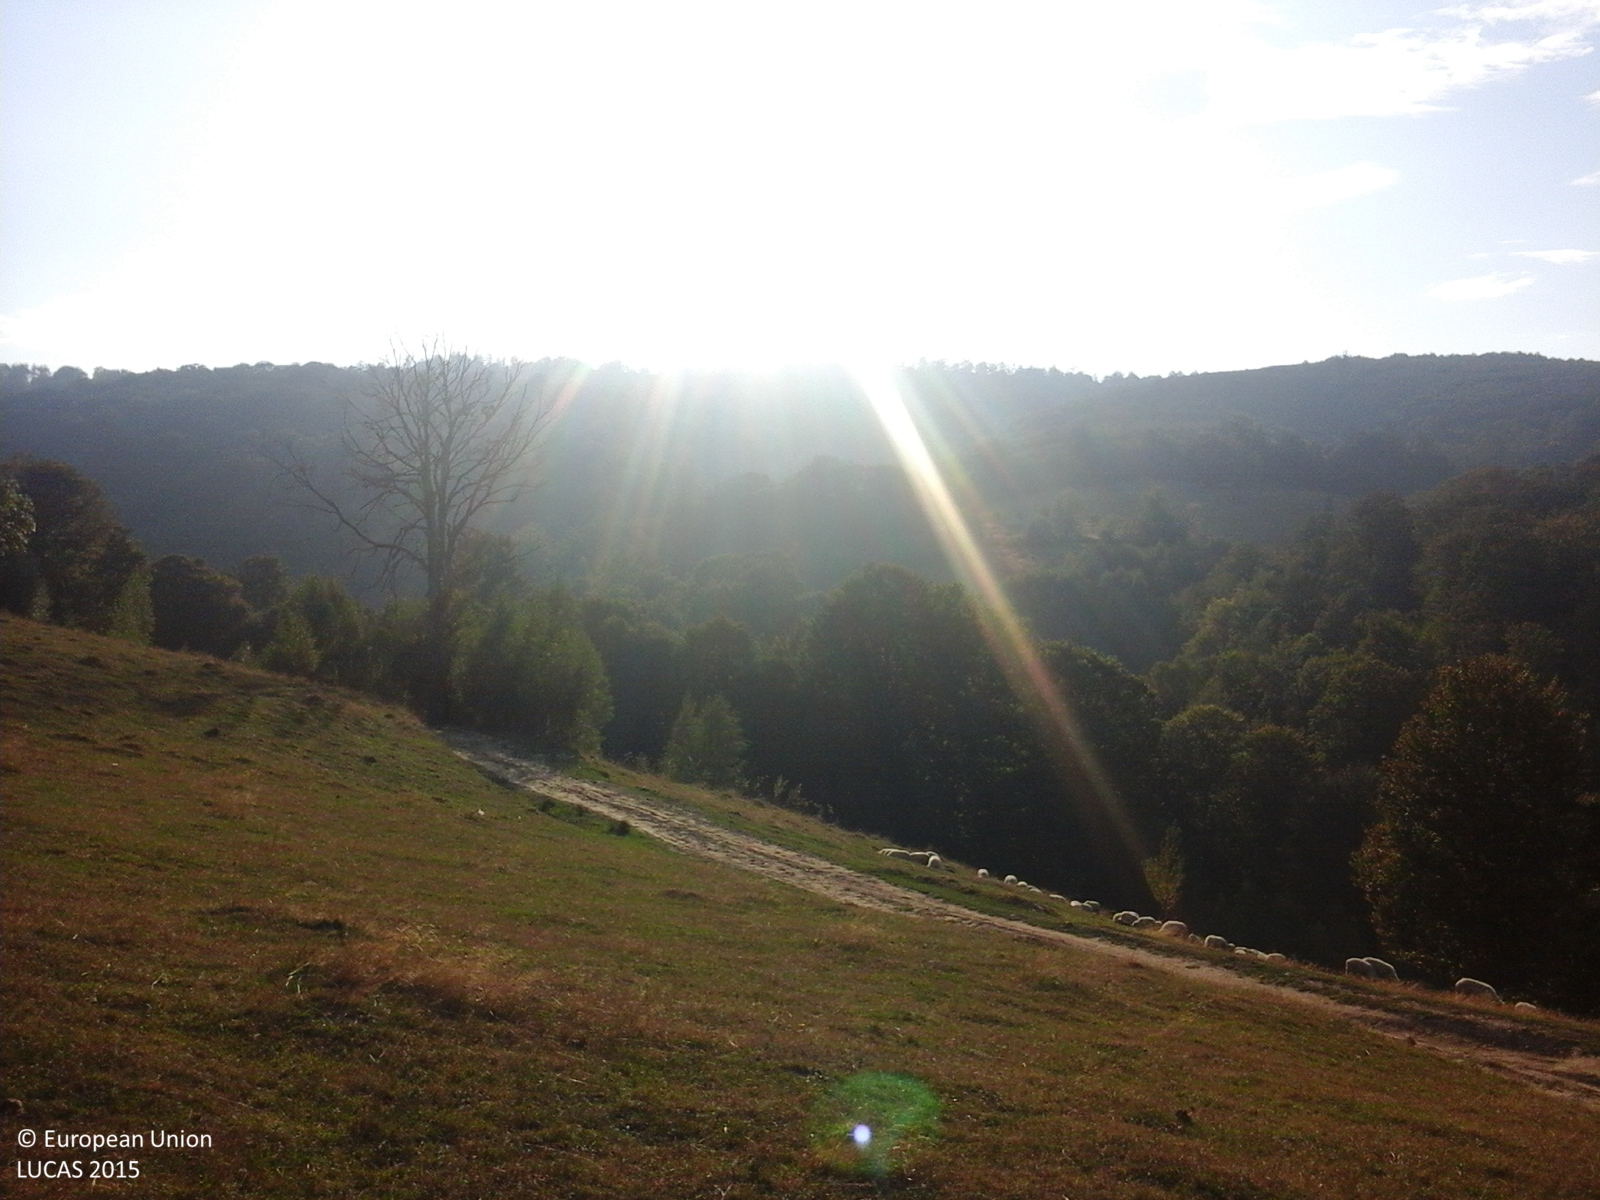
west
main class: Grassland
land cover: Grassland without tree/shrub cover
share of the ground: > 75 %
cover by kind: herbaceous plants 100 %
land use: Agriculture (excluding fallow land and kitchen gardens)
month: September
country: RO
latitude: 45.1596
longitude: 22.1876
